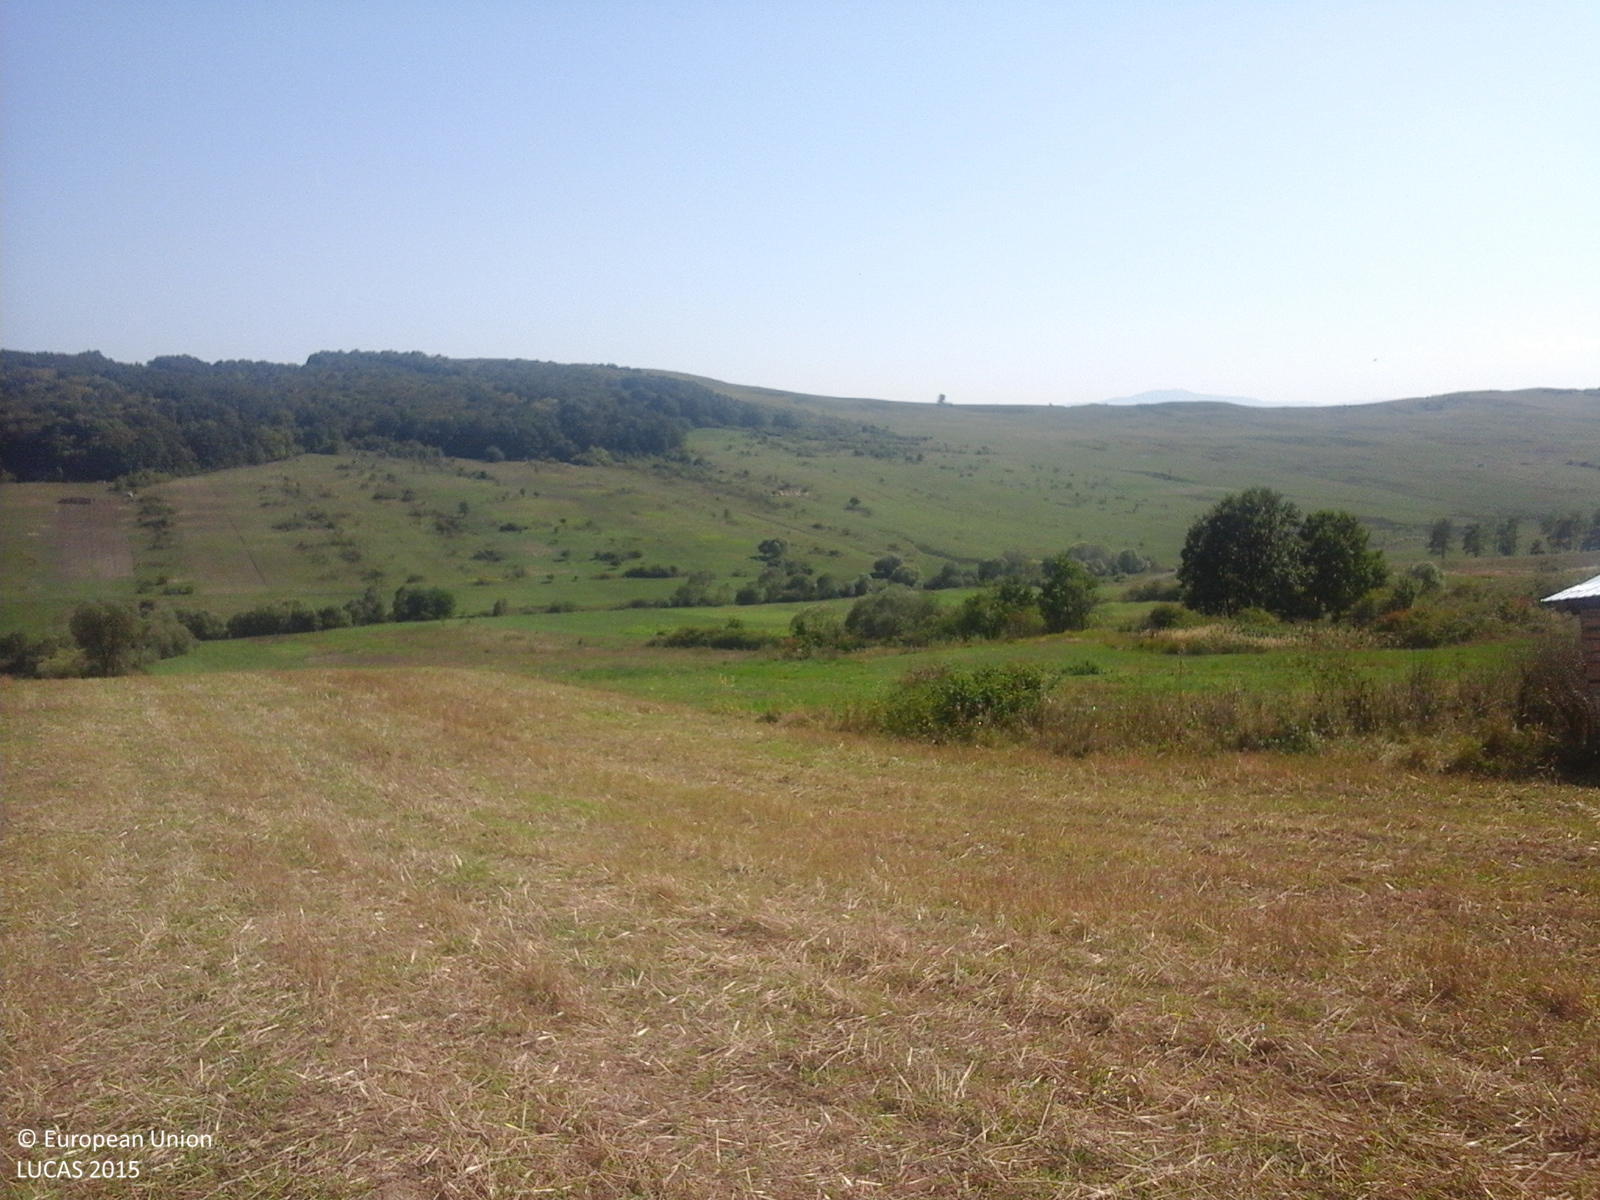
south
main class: Cropland
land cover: Common wheat
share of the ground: < 10 %
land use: Agriculture (excluding fallow land and kitchen gardens)
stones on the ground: < 10 %
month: September
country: RO
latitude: 47.1621
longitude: 22.8158
